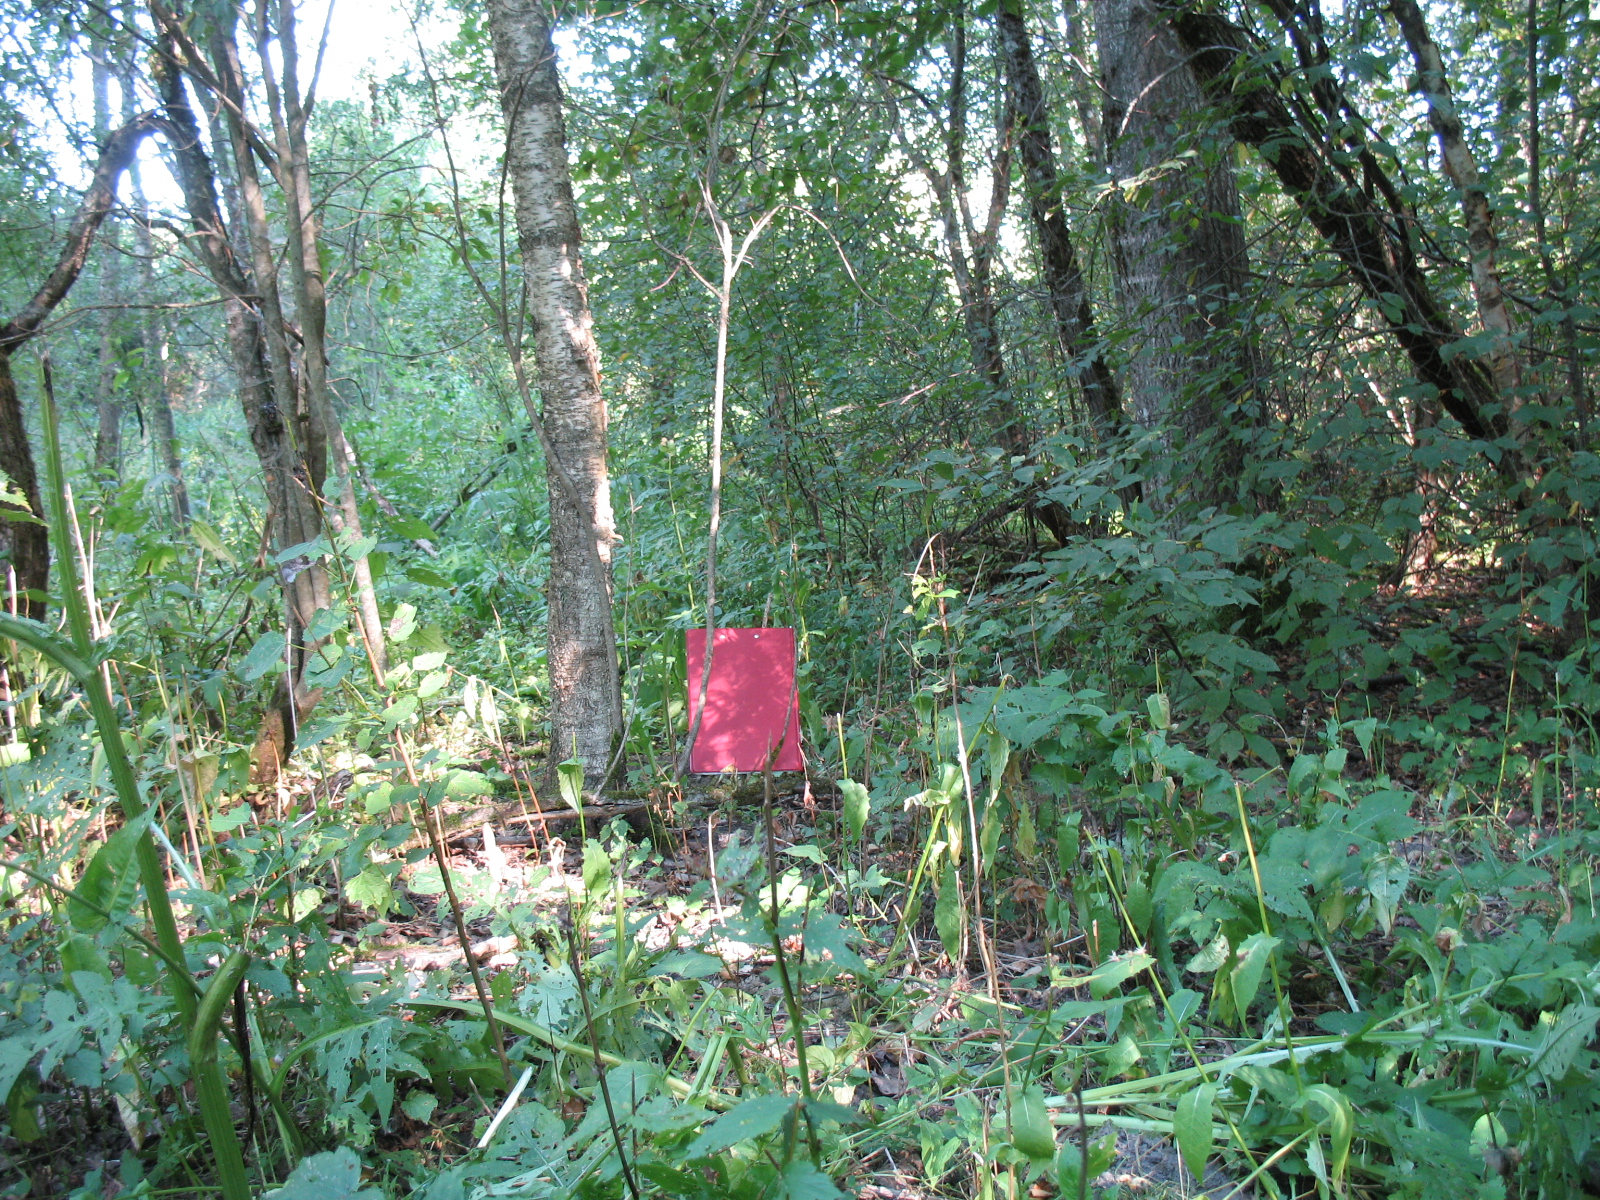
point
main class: Woodland
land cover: Broadleaved woodland
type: non-riverine alder, birch or aspen forest
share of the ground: 50 - 75 %
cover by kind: broadleaved forest trees 65 %, herbaceous plants 25 %, shrubs 10 %
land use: Forestry
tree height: > 5 m
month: August
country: LV
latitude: 56.4352
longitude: 25.6112
